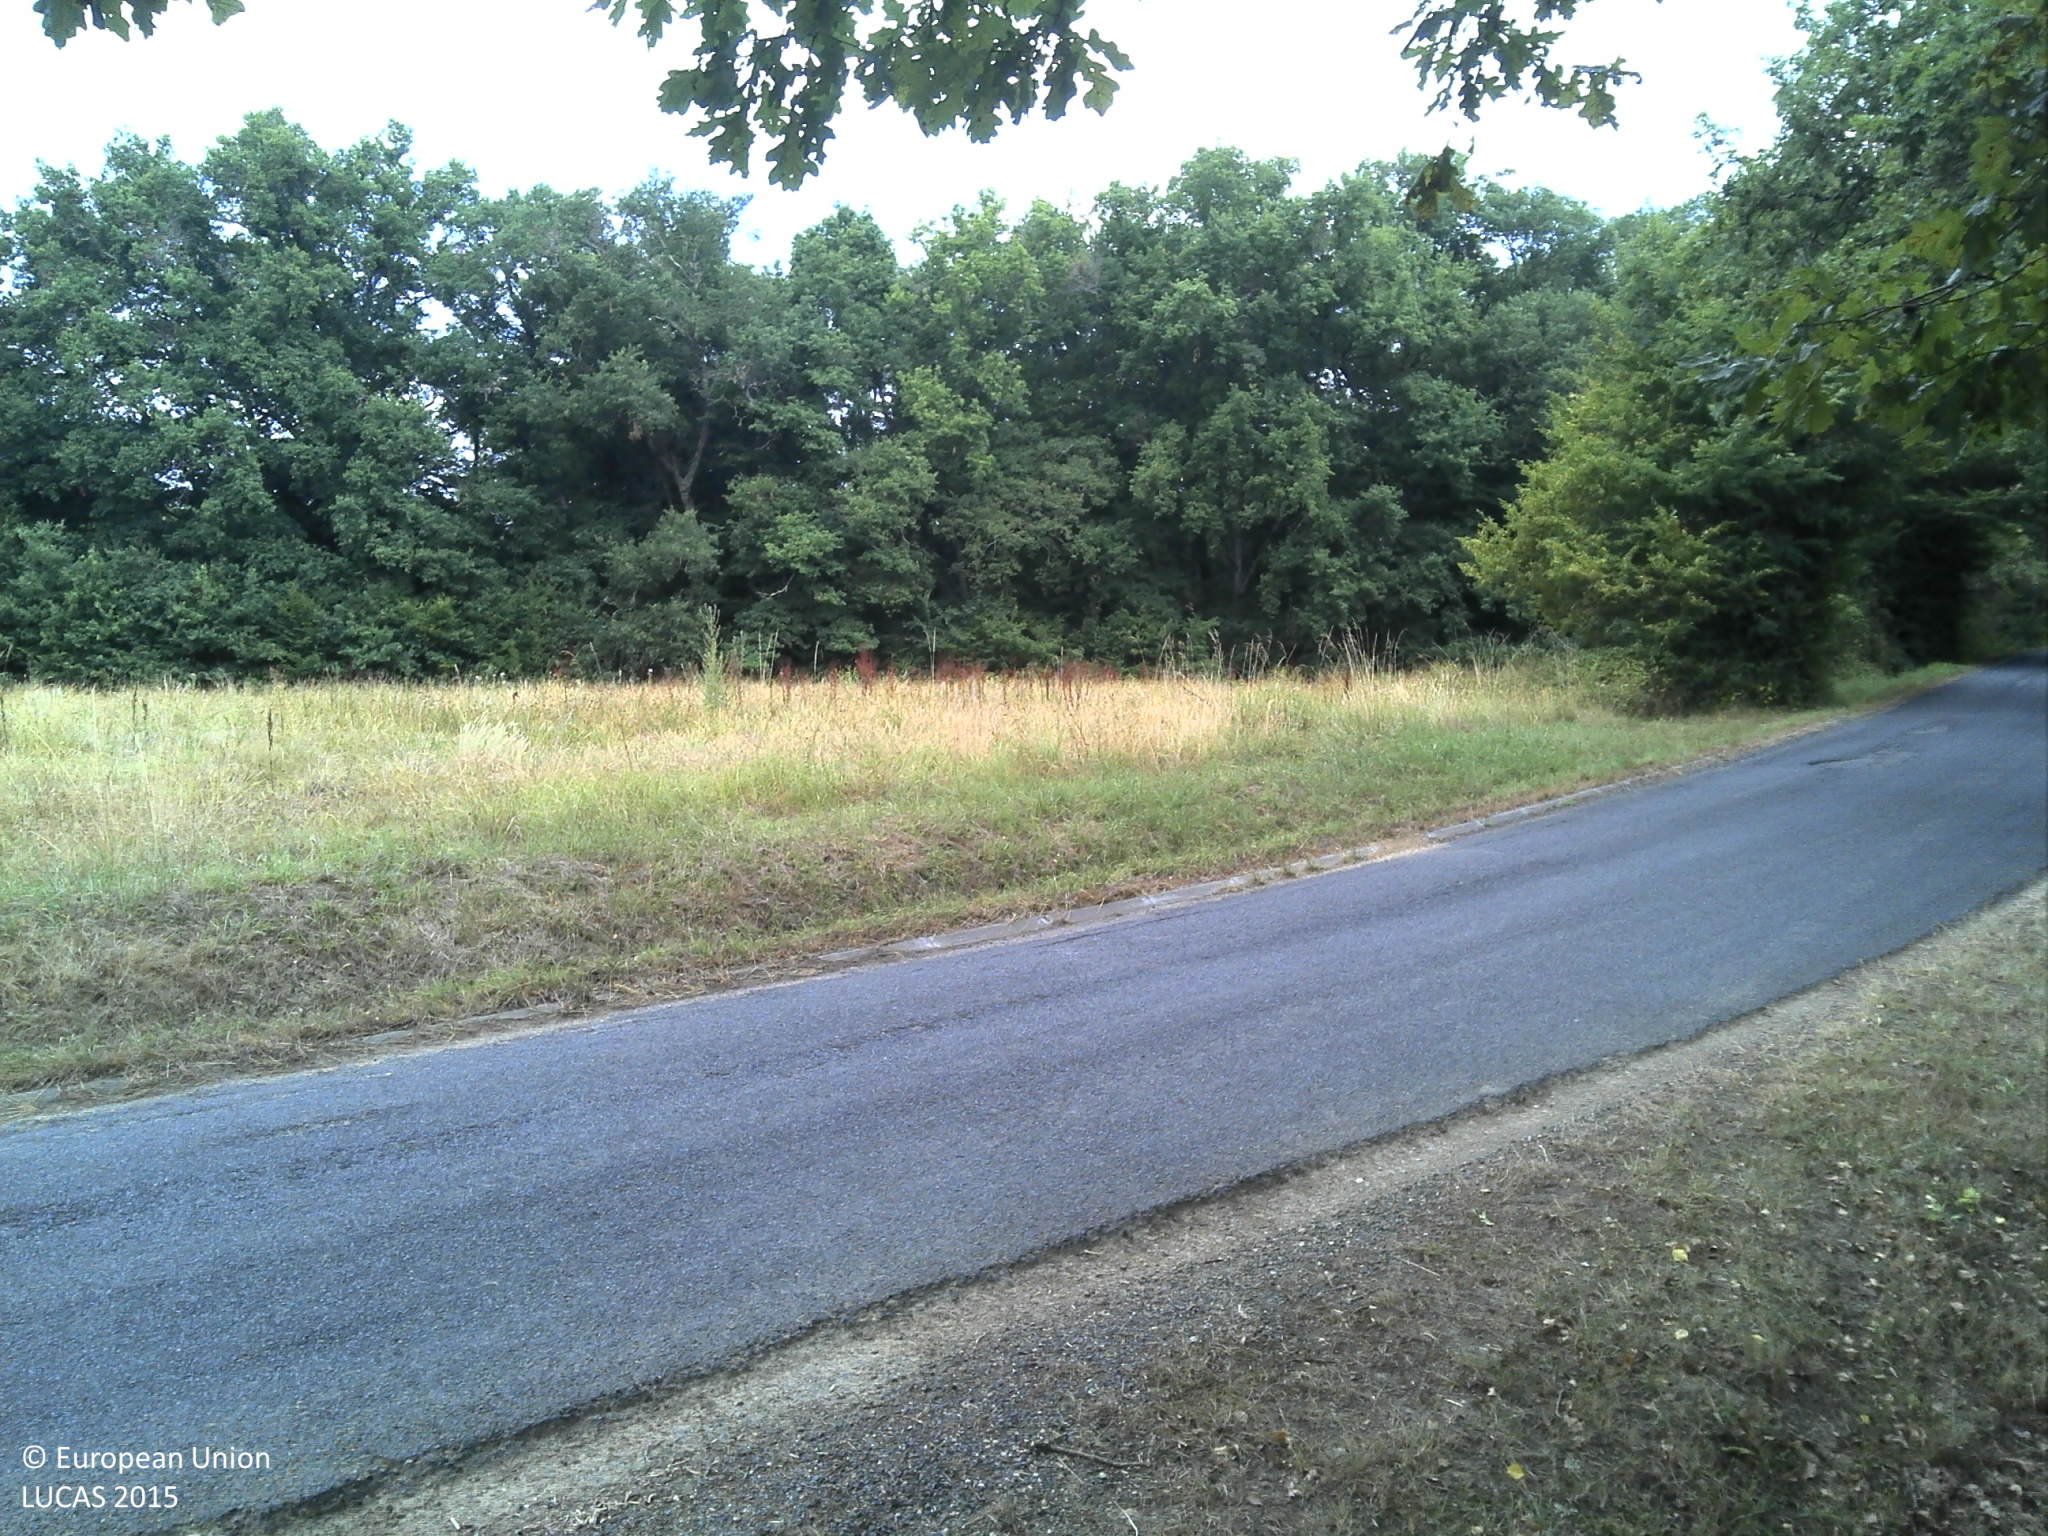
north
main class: Woodland
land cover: Broadleaved woodland
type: thermophilous deciduous forest
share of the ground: > 75 %
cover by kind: broadleaved forest trees 100 %
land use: Forestry
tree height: > 5 m
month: July
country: FR
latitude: 44.8055
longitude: -0.4222
